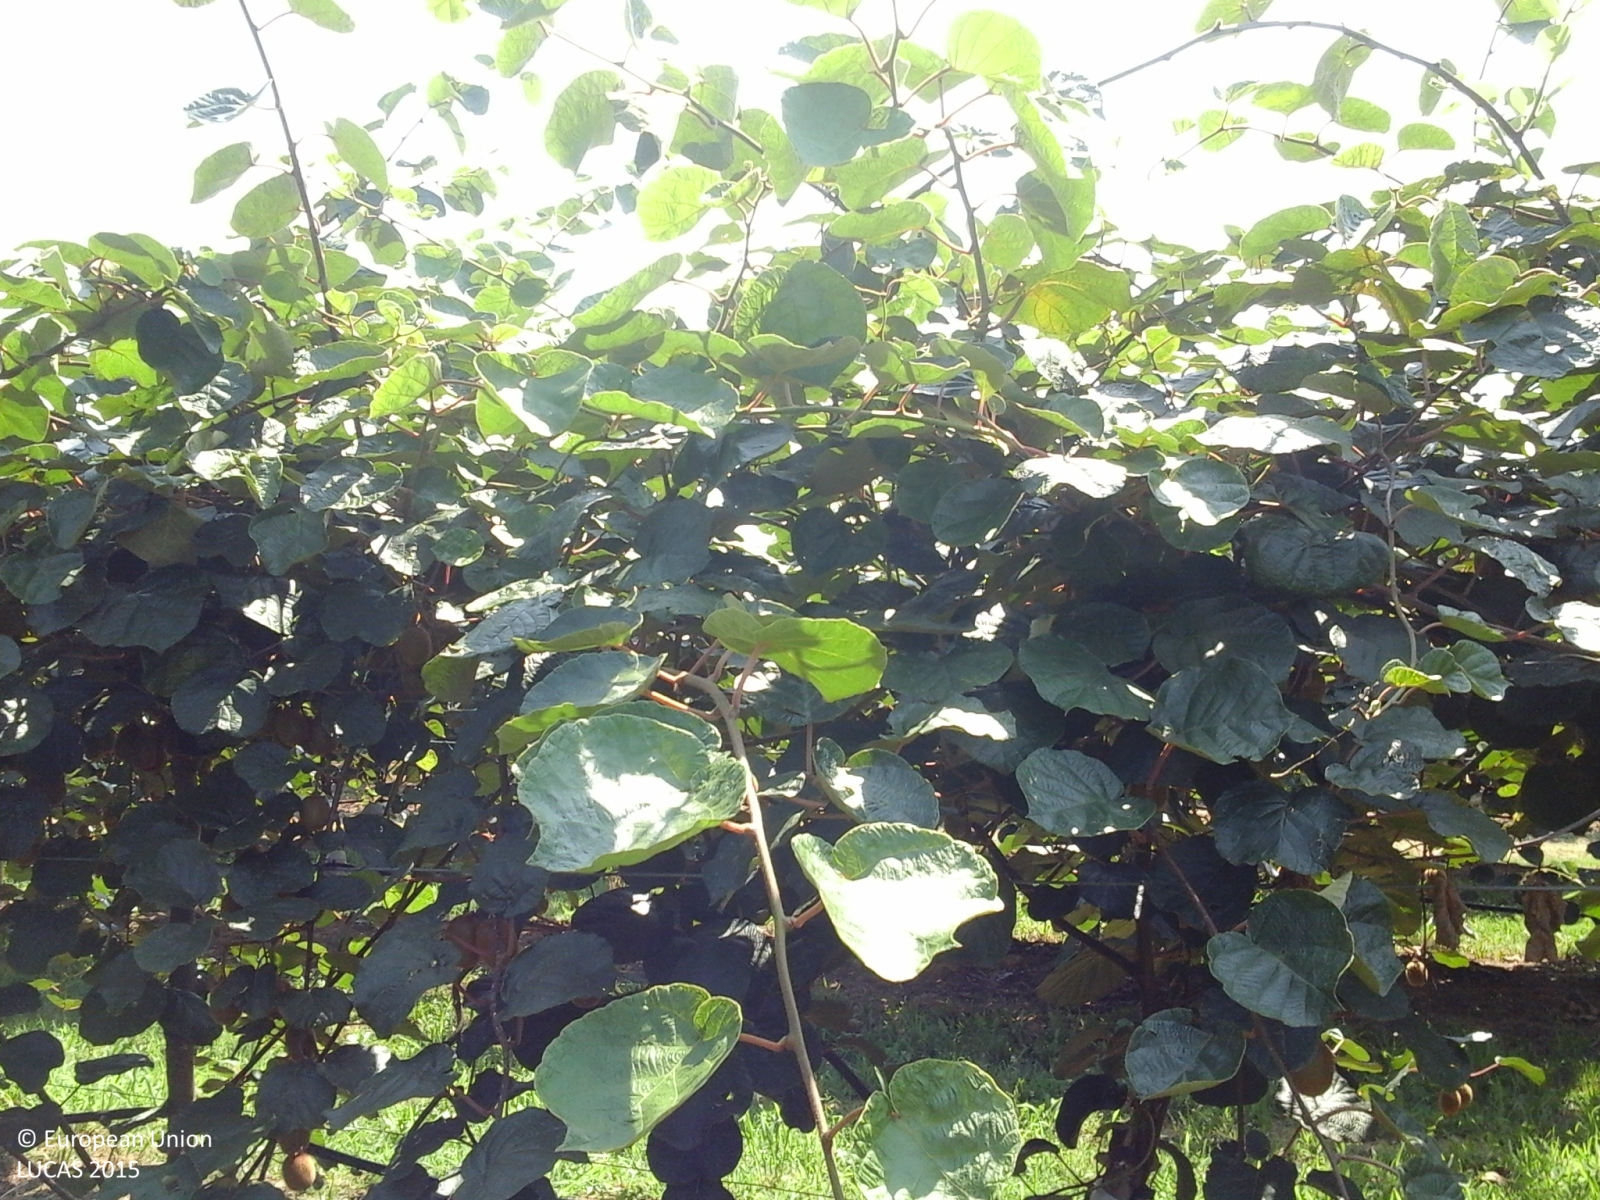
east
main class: Cropland
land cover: Other fruit trees and berries
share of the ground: > 75 %
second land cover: Spontaneously vegetated surfaces
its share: > 75 %
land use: Agriculture (excluding fallow land and kitchen gardens)
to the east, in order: Other fruit trees and berries; Spontaneously vegetated surfaces; Grass margins; Ditches and canals; Grass margins; Vineyards; Grass margins; Ditches and canals; Grass margins; Other fruit trees and berries; Electric lines; Other fruit trees and berries; Grass margins; Ditches and canals; Grass margins; Other bare soil; Vineyards
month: July
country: IT
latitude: 44.3729
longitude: 11.6905
